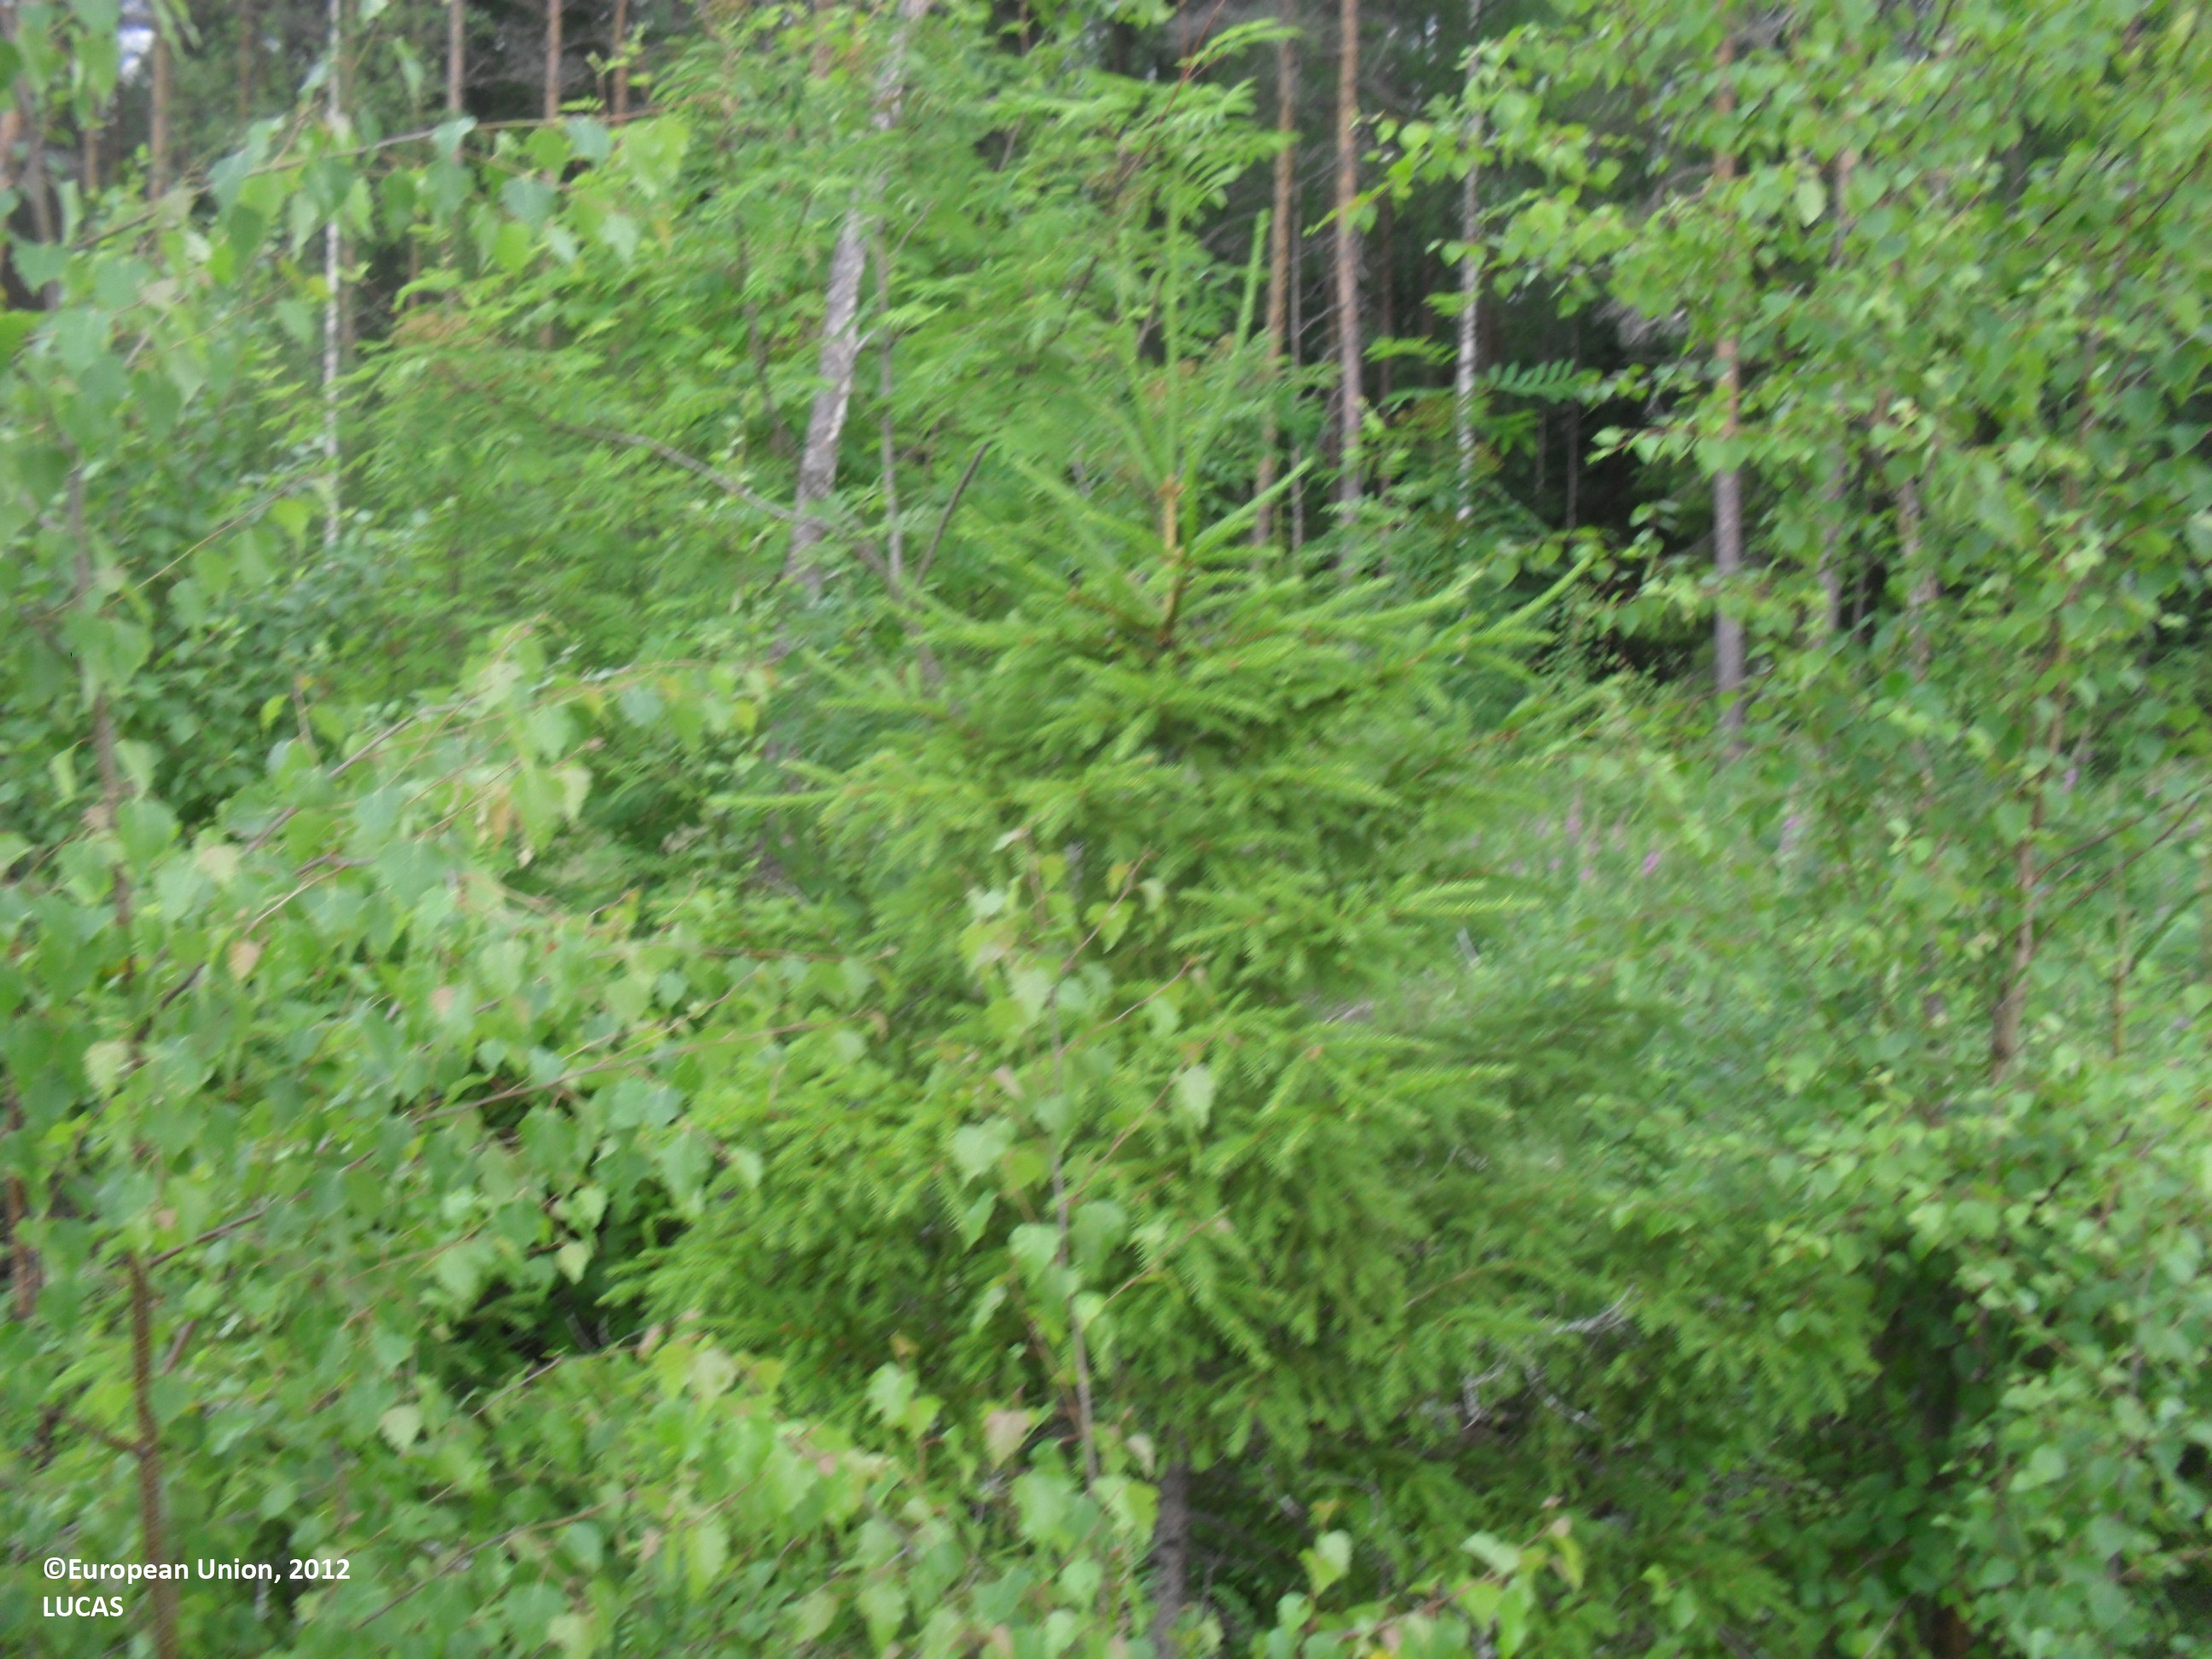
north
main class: Shrubland
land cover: Shrubland with sparse tree cover
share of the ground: 50 - 75 %
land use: Forestry
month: July
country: FI
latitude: 63.4352
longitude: 23.6743
